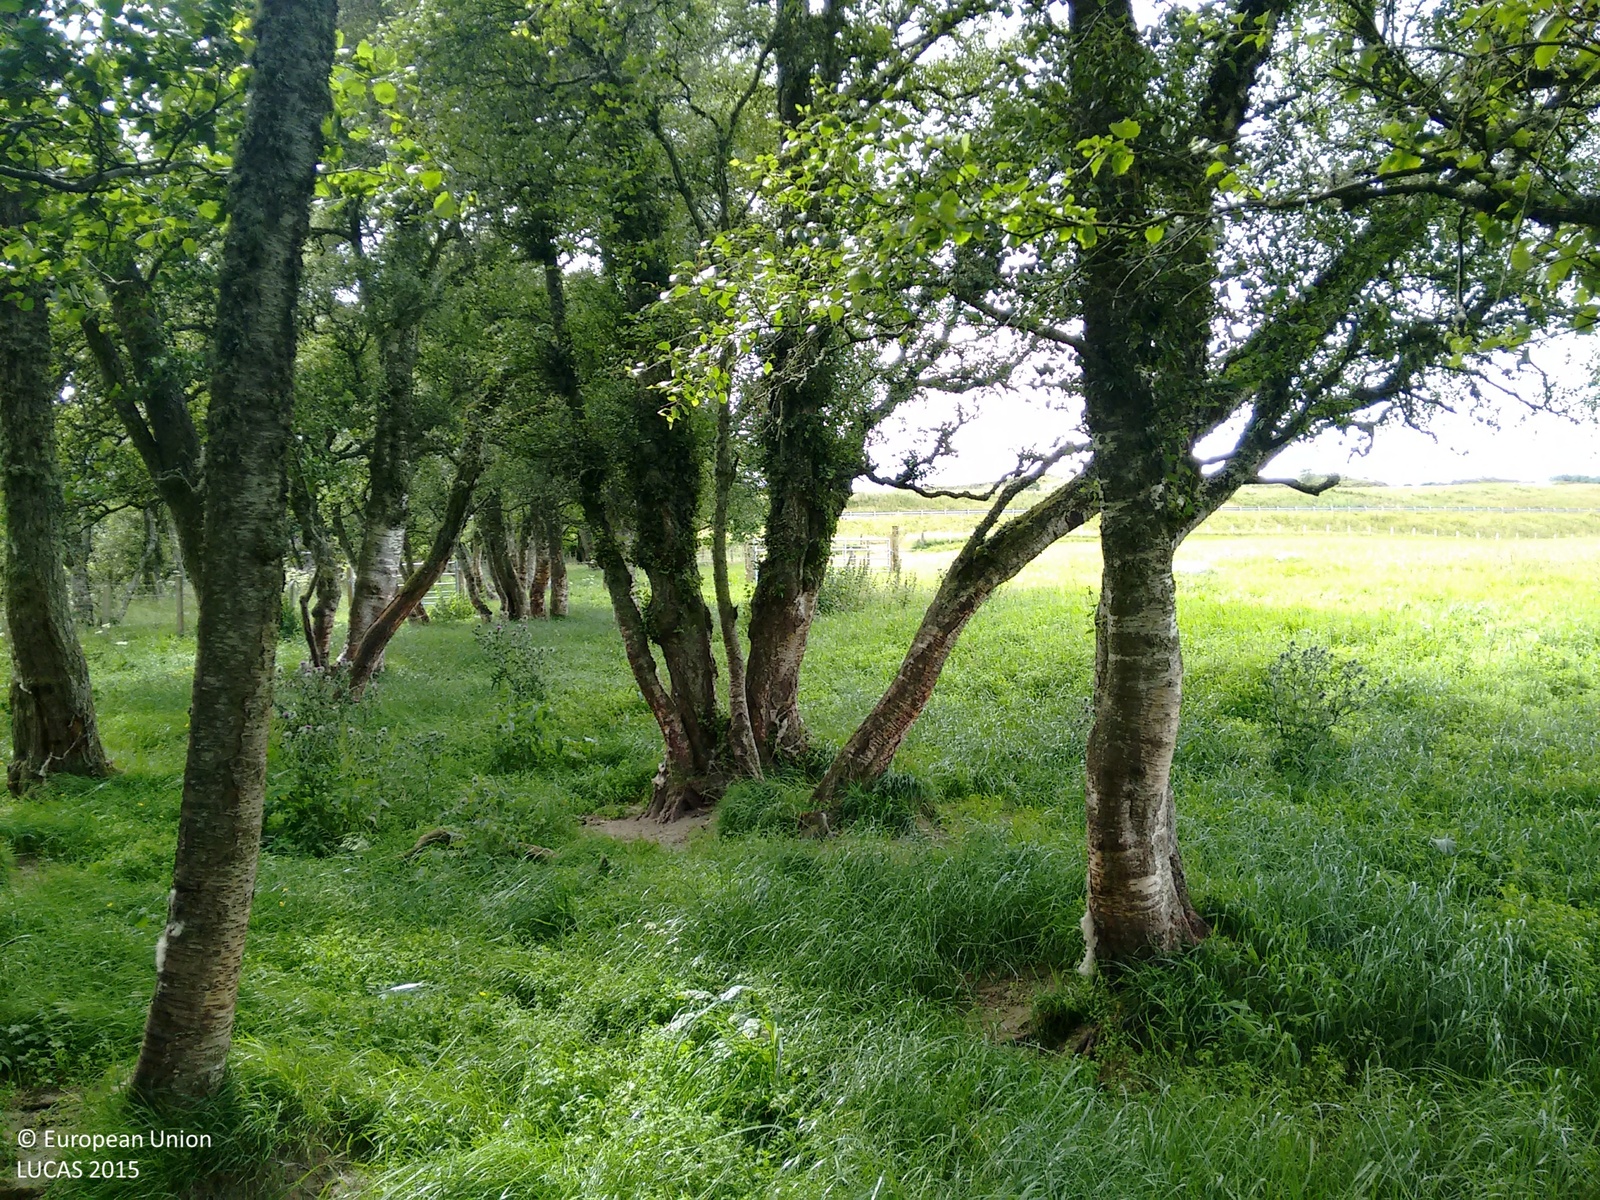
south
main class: Woodland
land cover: Broadleaved woodland
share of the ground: > 75 %
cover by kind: broadleaved forest trees 100 %
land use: Agriculture (excluding fallow land and kitchen gardens)
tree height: > 5 m
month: August
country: GB
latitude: 57.4105
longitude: -4.1502
